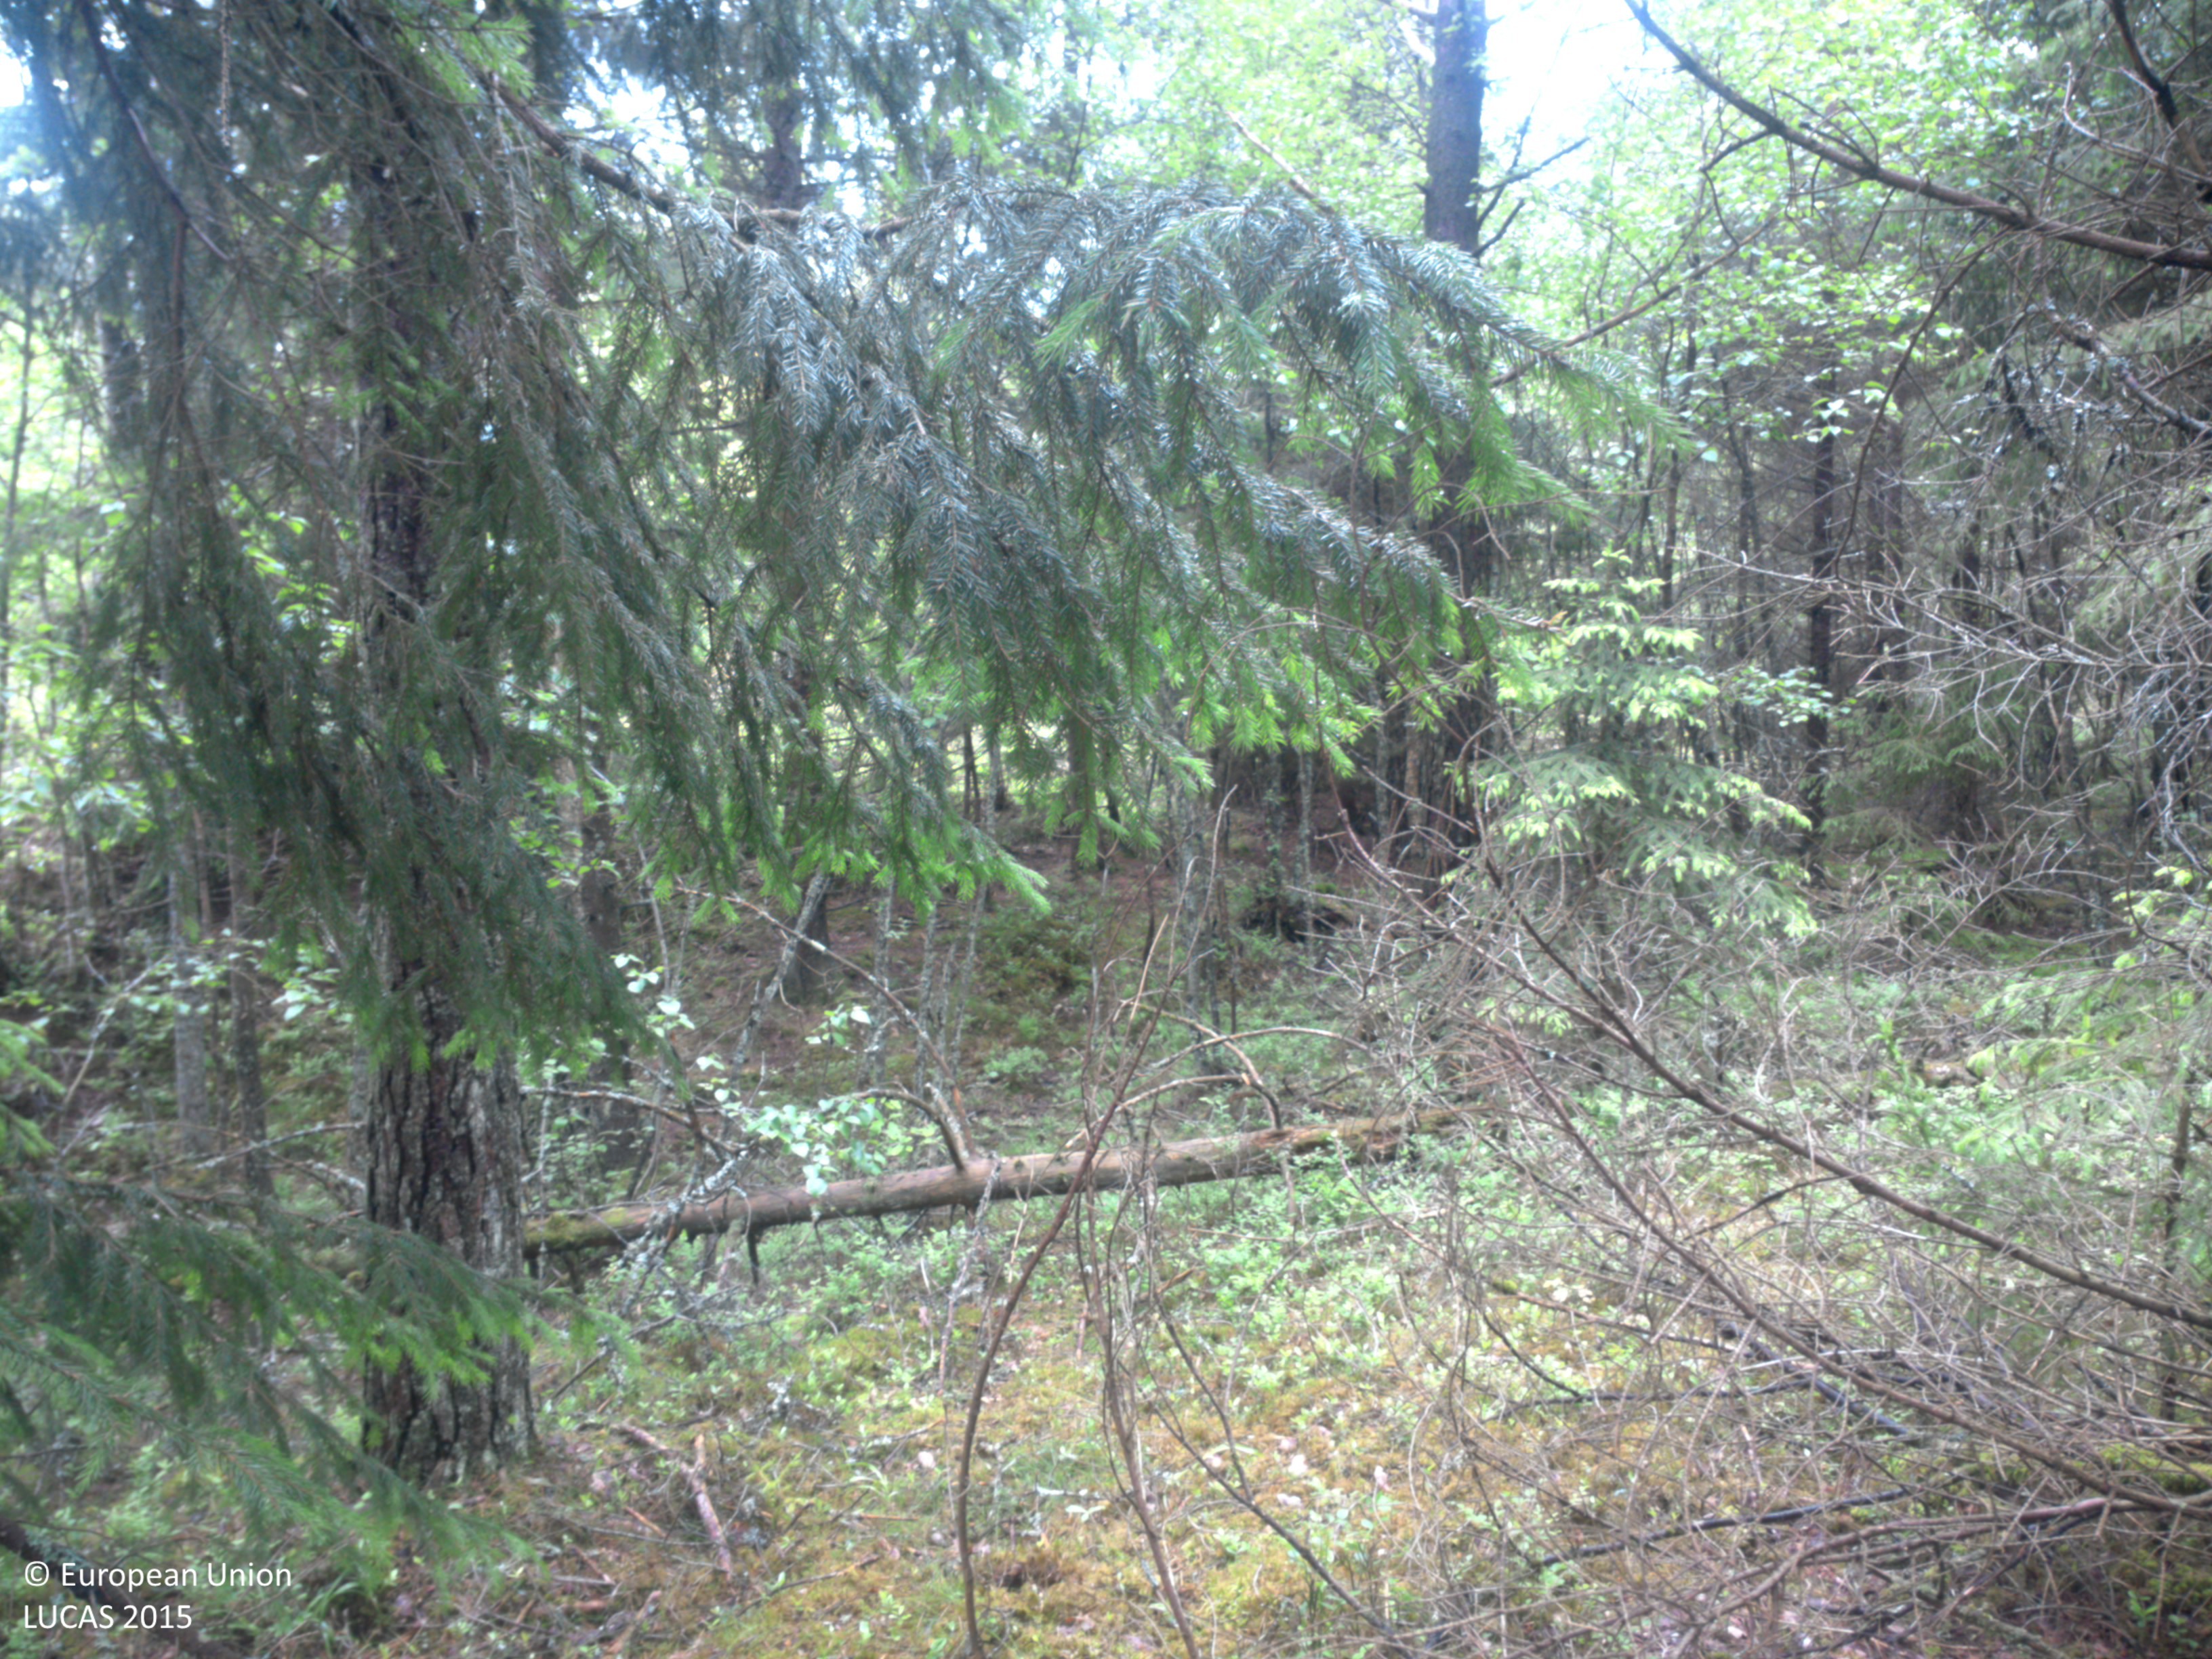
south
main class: Woodland
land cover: Spruce dominated coniferous woodland
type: boreal forest
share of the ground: 50 - 75 %
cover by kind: coniferous forest trees 50 %, lichens and mosses 40 %, broadleaved forest trees 5 %, shrubs 5 %
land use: Forestry
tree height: > 5 m
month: June
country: SE
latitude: 58.4773
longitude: 11.7968
